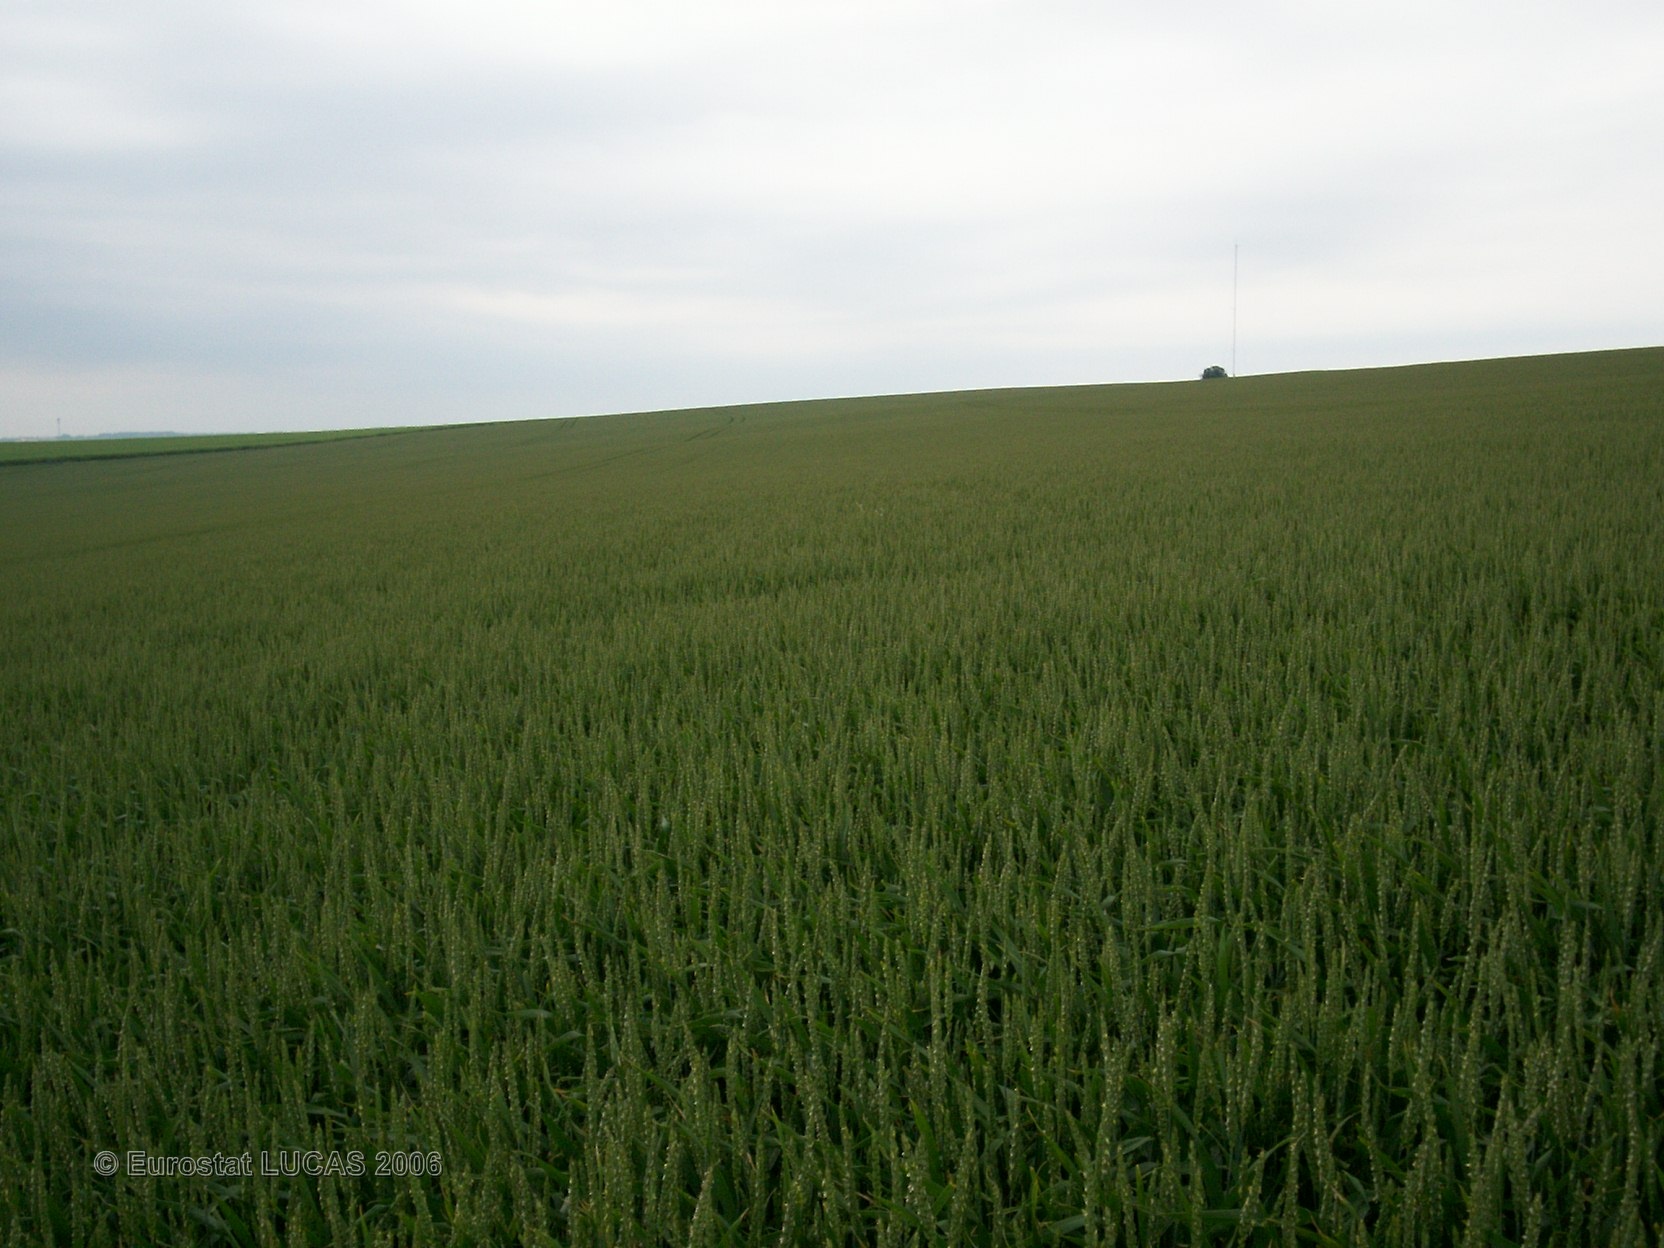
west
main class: Cropland
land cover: Common wheat
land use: Agriculture (excluding fallow land and kitchen gardens)
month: June
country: FR
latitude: 48.7516
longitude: 4.4611
